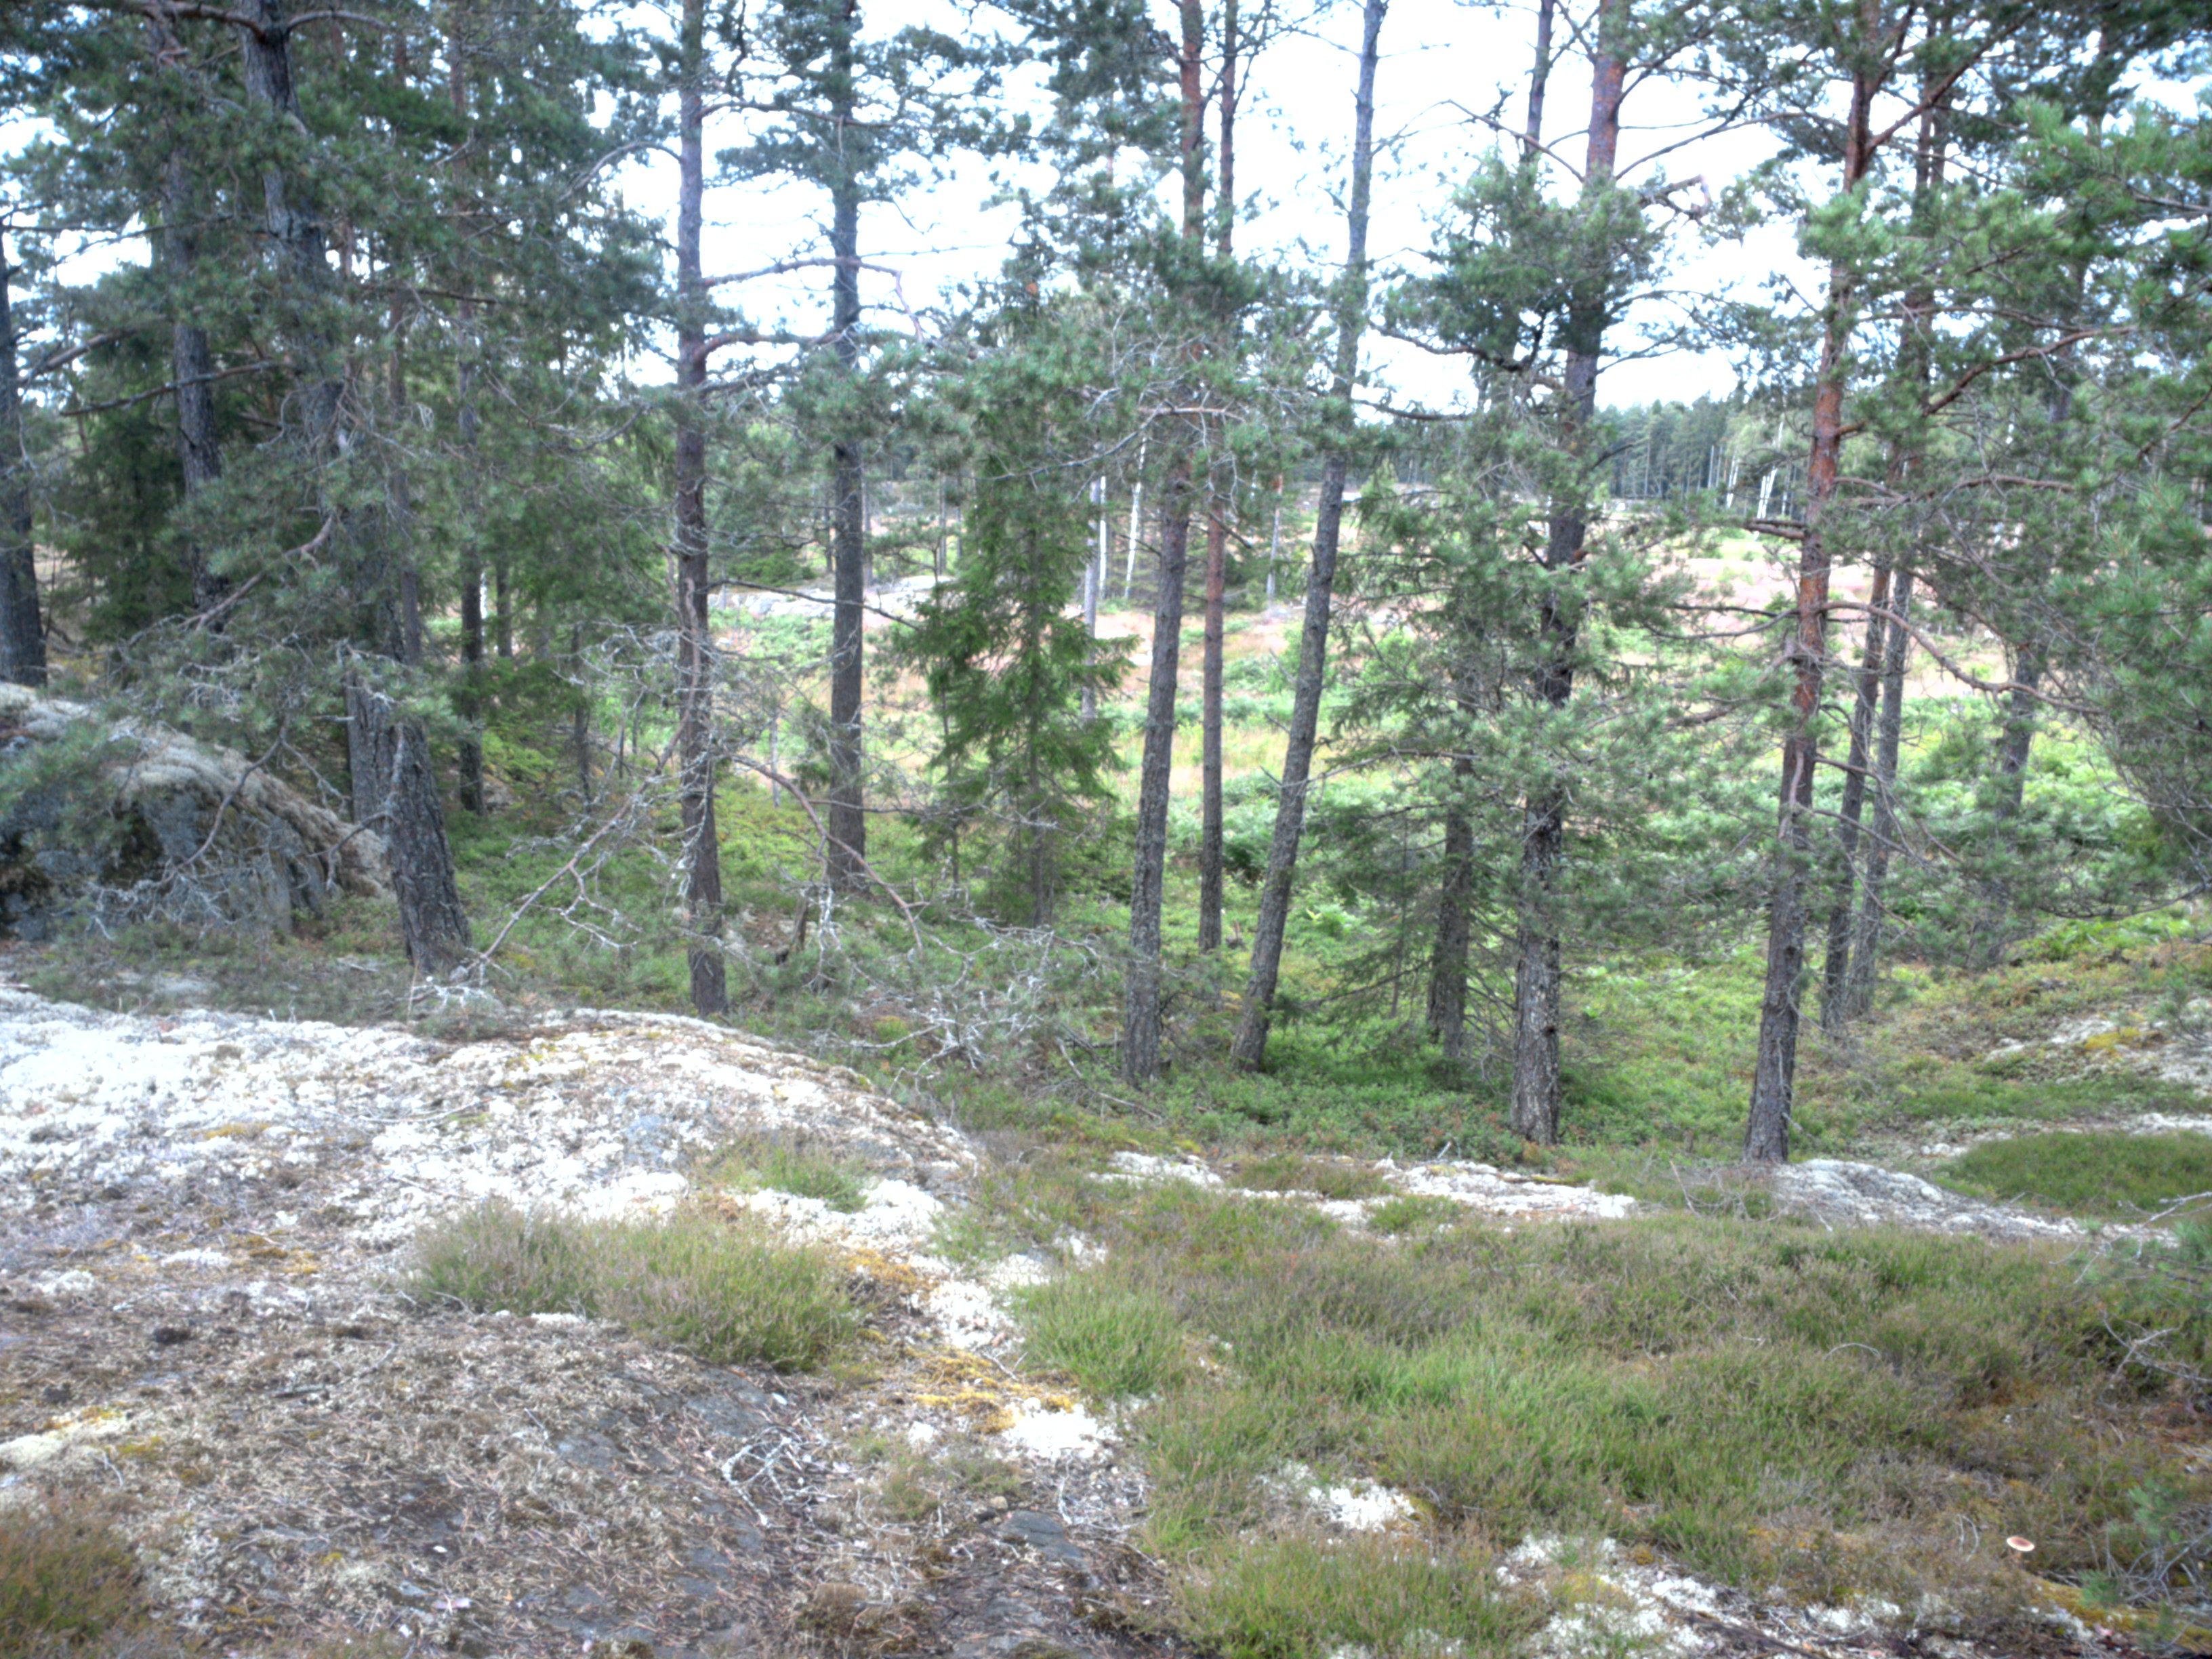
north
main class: Woodland
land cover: Pine dominated coniferous woodland
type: boreal forest
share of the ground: 25 - 50 %
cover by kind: shrubs 35 %, lichens and mosses 35 %, coniferous forest trees 30 %
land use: Forestry
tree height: > 5 m
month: July
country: SE
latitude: 59.0917
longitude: 18.1862
